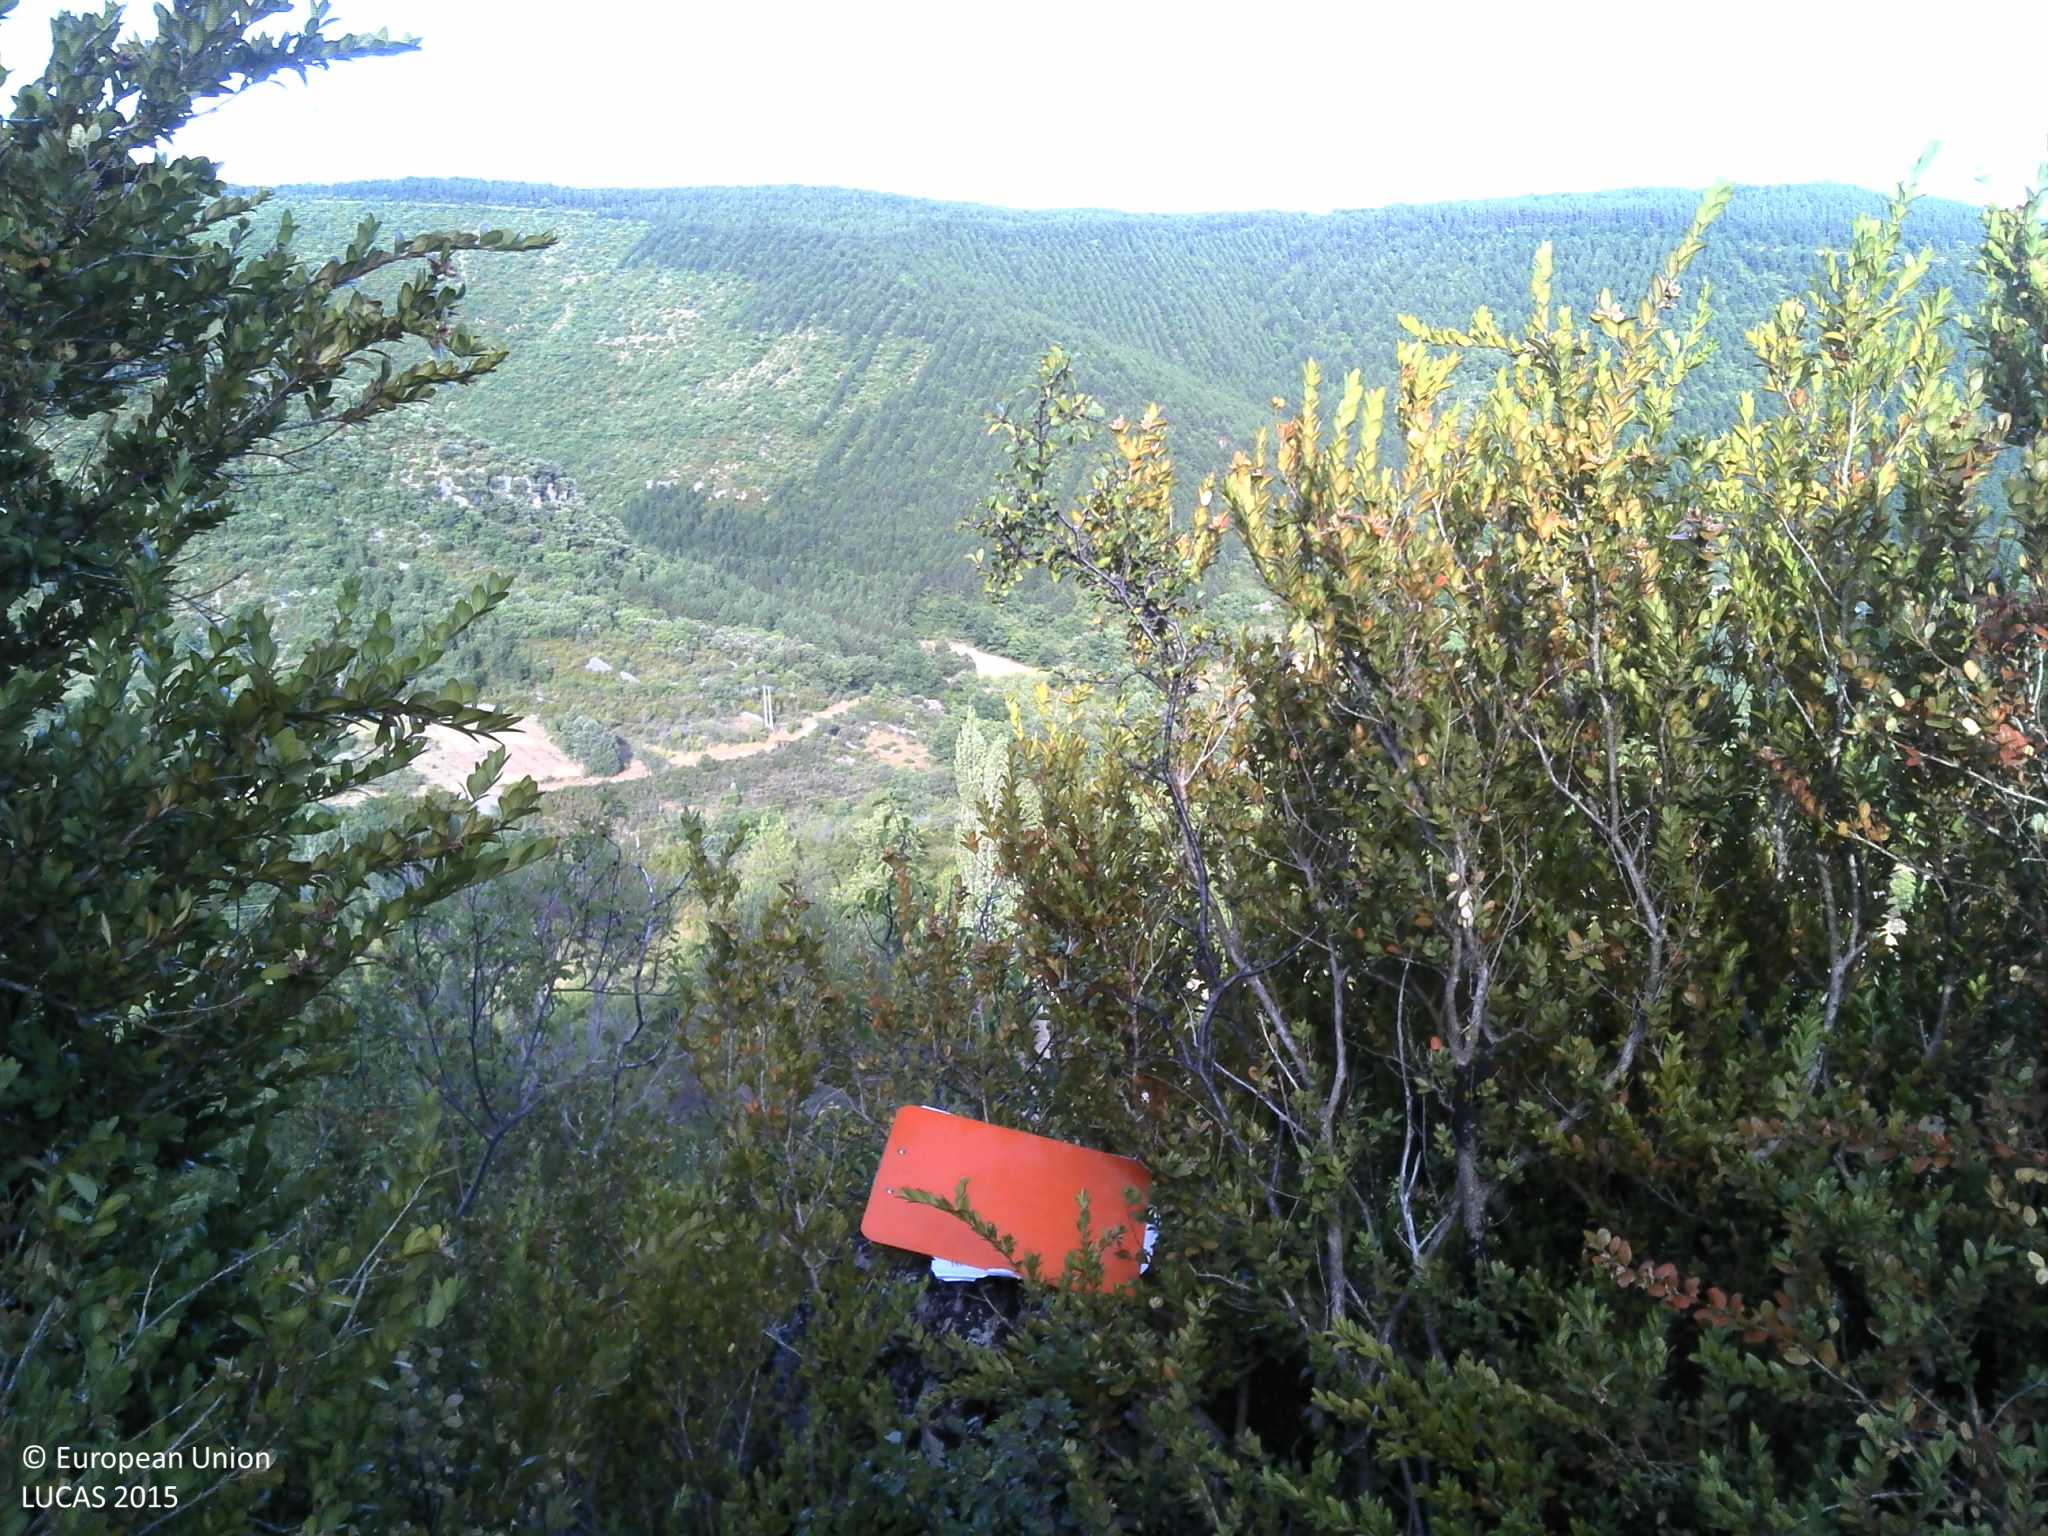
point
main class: Shrubland
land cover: Shrubland without tree cover
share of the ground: > 75 %
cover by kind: shrubs 80 %, herbaceous plants 10 %, consolidated bare surface 10 %
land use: Semi-natural and natural areas not in use
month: July
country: FR
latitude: 43.7467
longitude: 3.1900
